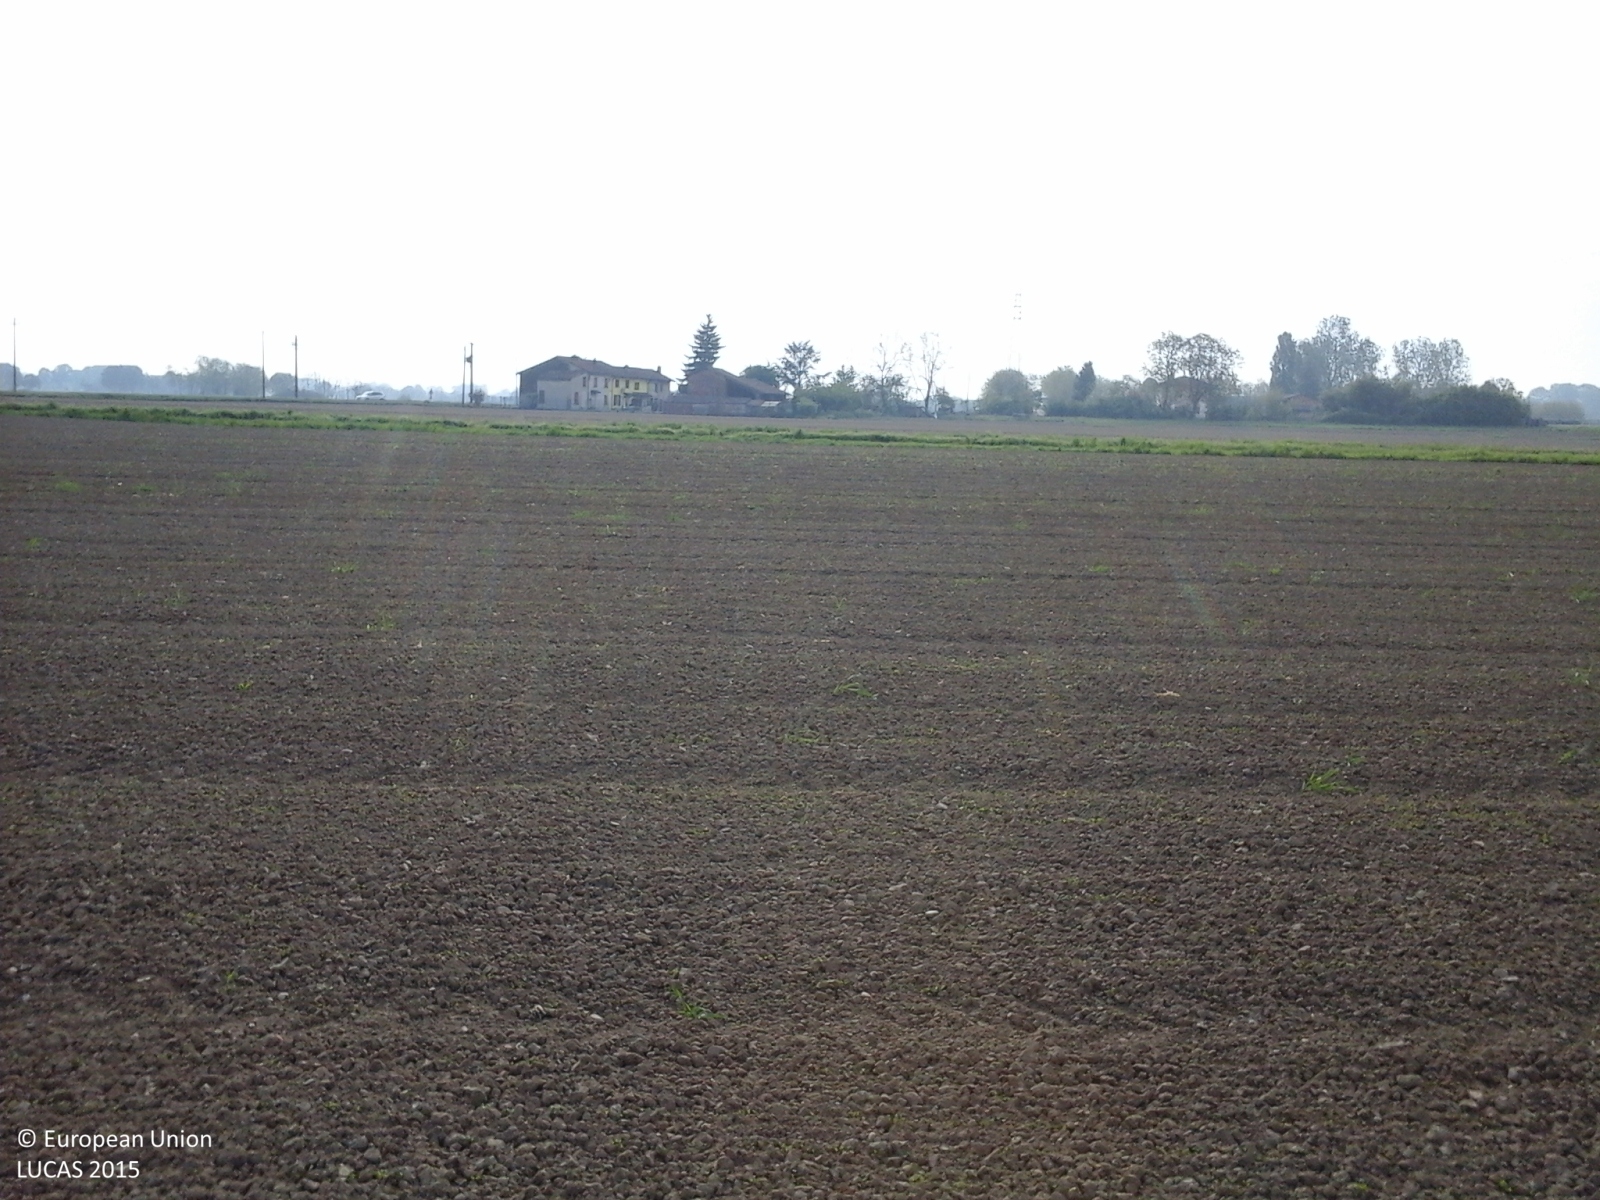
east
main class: Cropland
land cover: Lucerne
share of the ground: < 10 %
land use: Agriculture (excluding fallow land and kitchen gardens)
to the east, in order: Lucerne; Grass margins; Tracks; Ditches and canals; Soya; Grass margins; Electric lines; Paved roads, cycling and walking lanes; Grass margins; Electric lines; Other bare soil
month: April
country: IT
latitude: 45.0880
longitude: 9.3786
